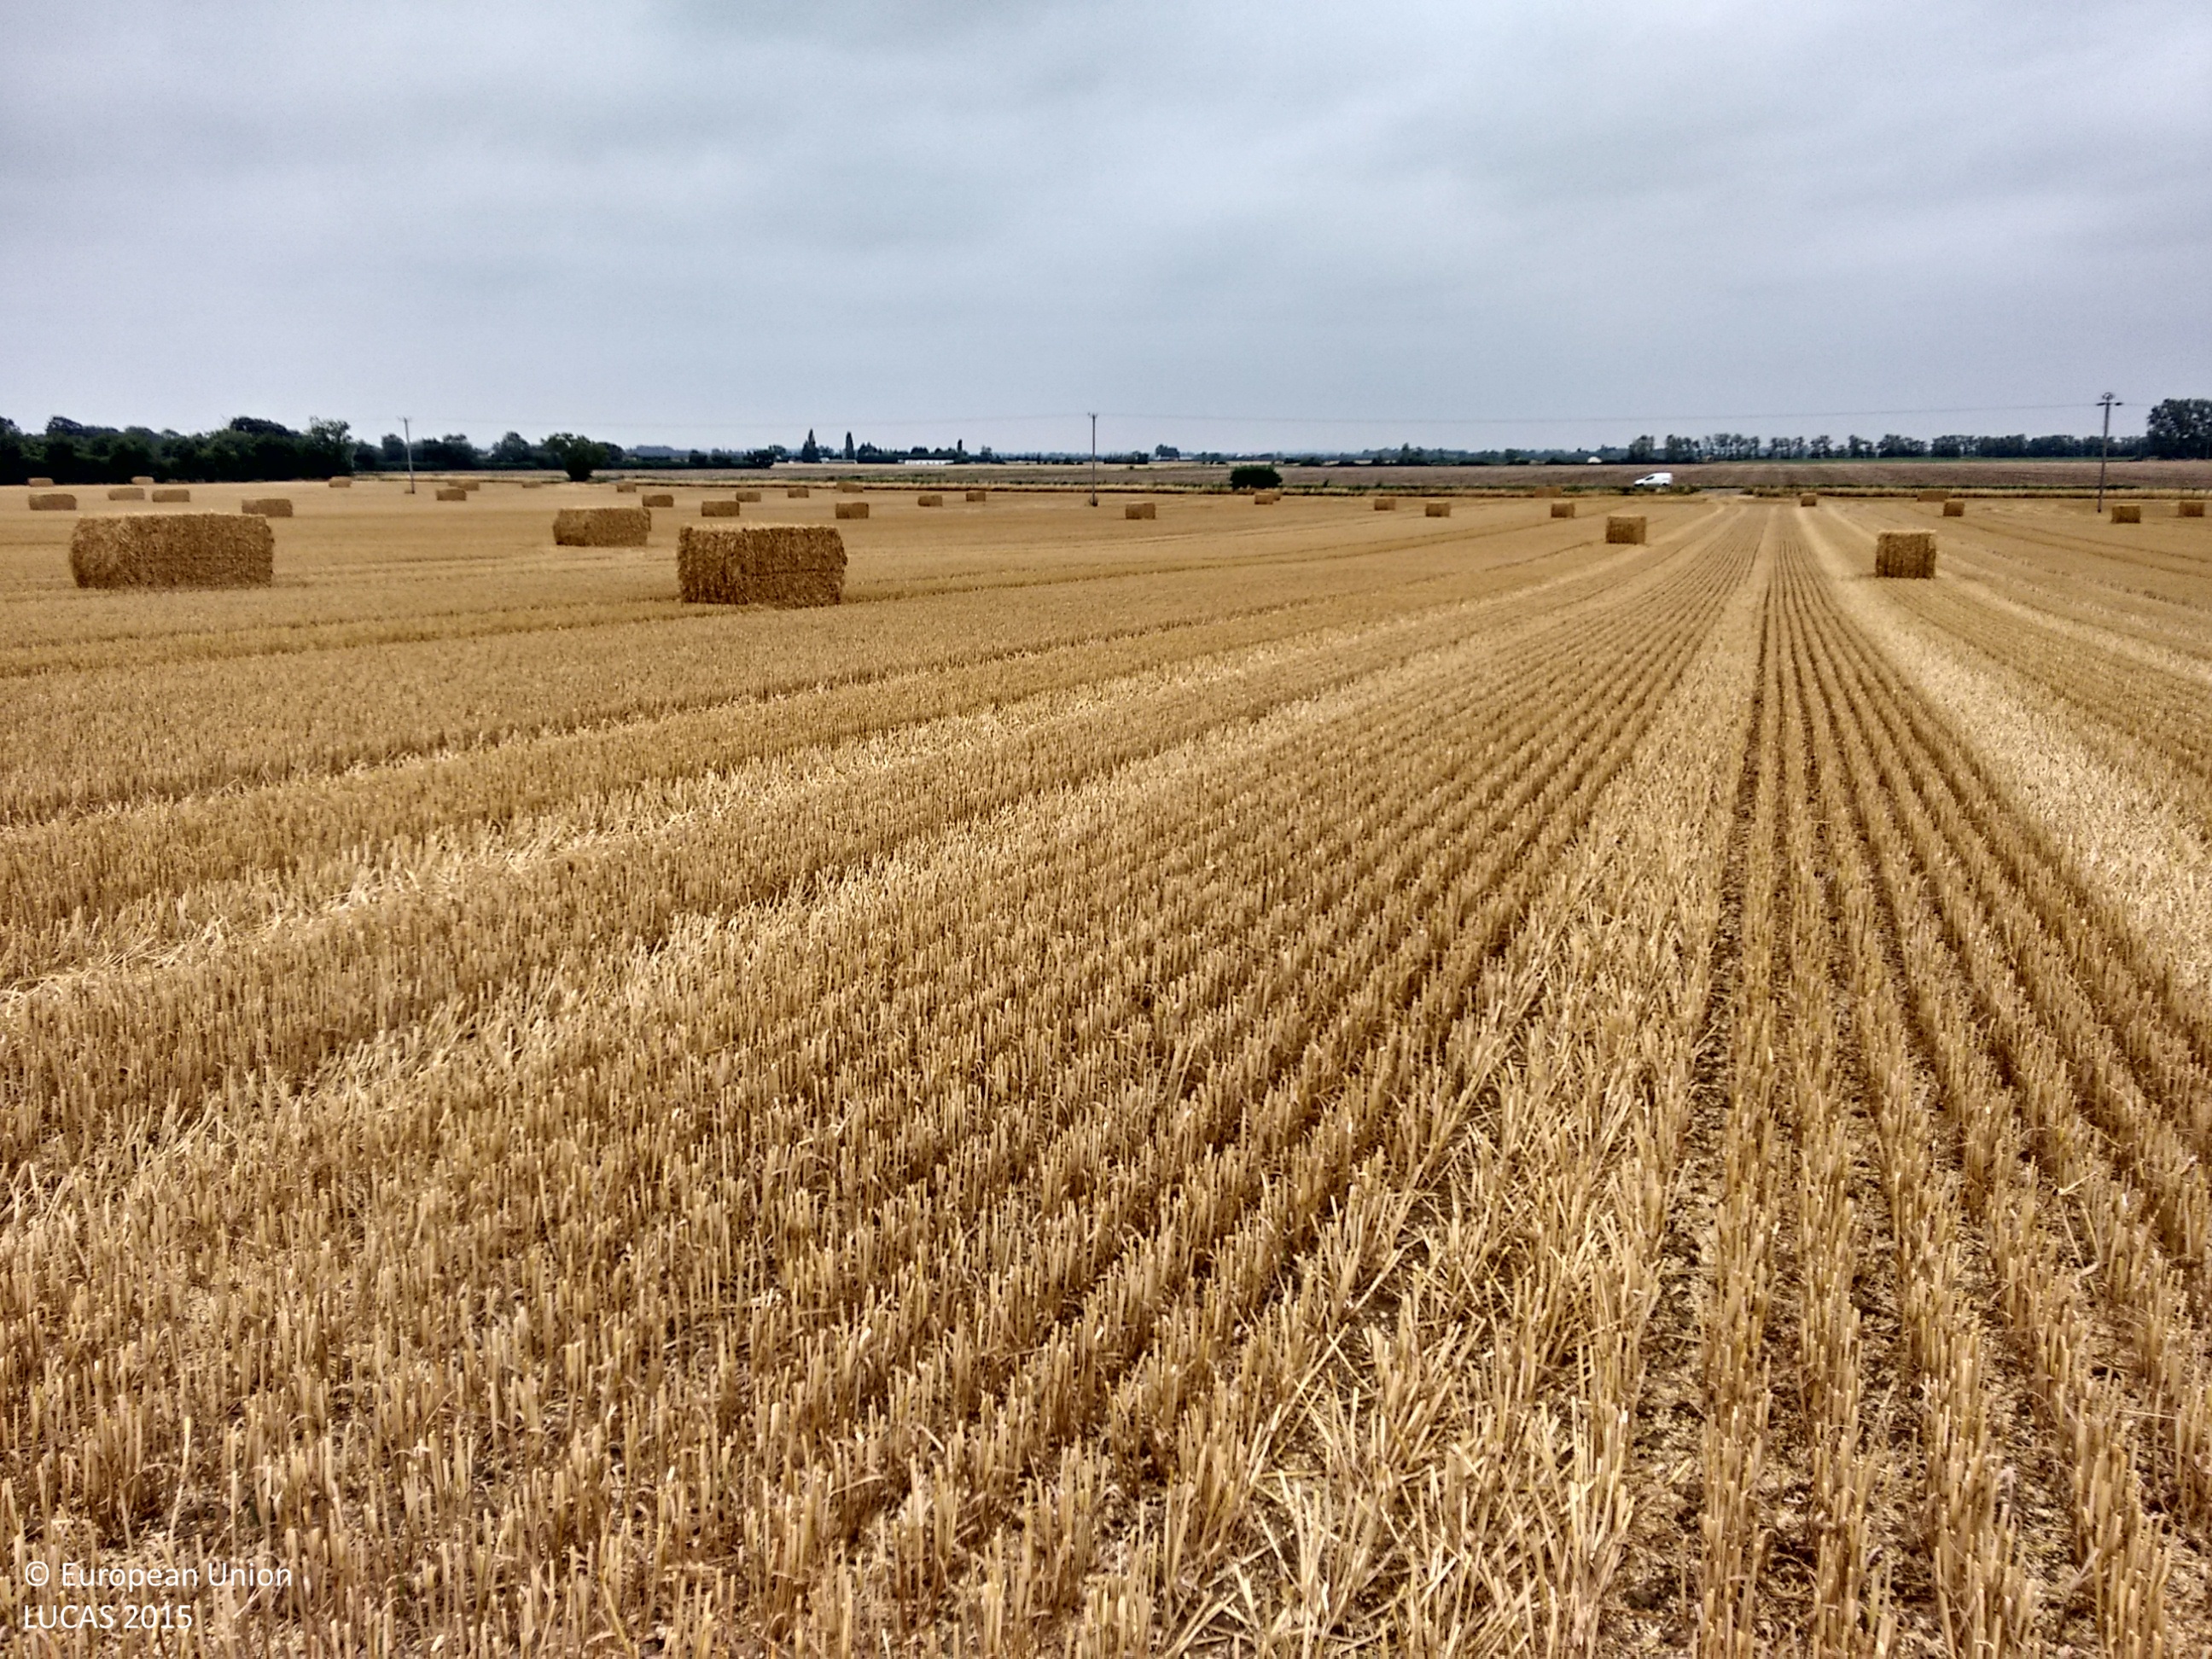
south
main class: Cropland
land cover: Common wheat
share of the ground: > 75 %
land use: Agriculture (excluding fallow land and kitchen gardens)
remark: Harvested field
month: August
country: GB
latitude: 52.3520
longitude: 0.2064
